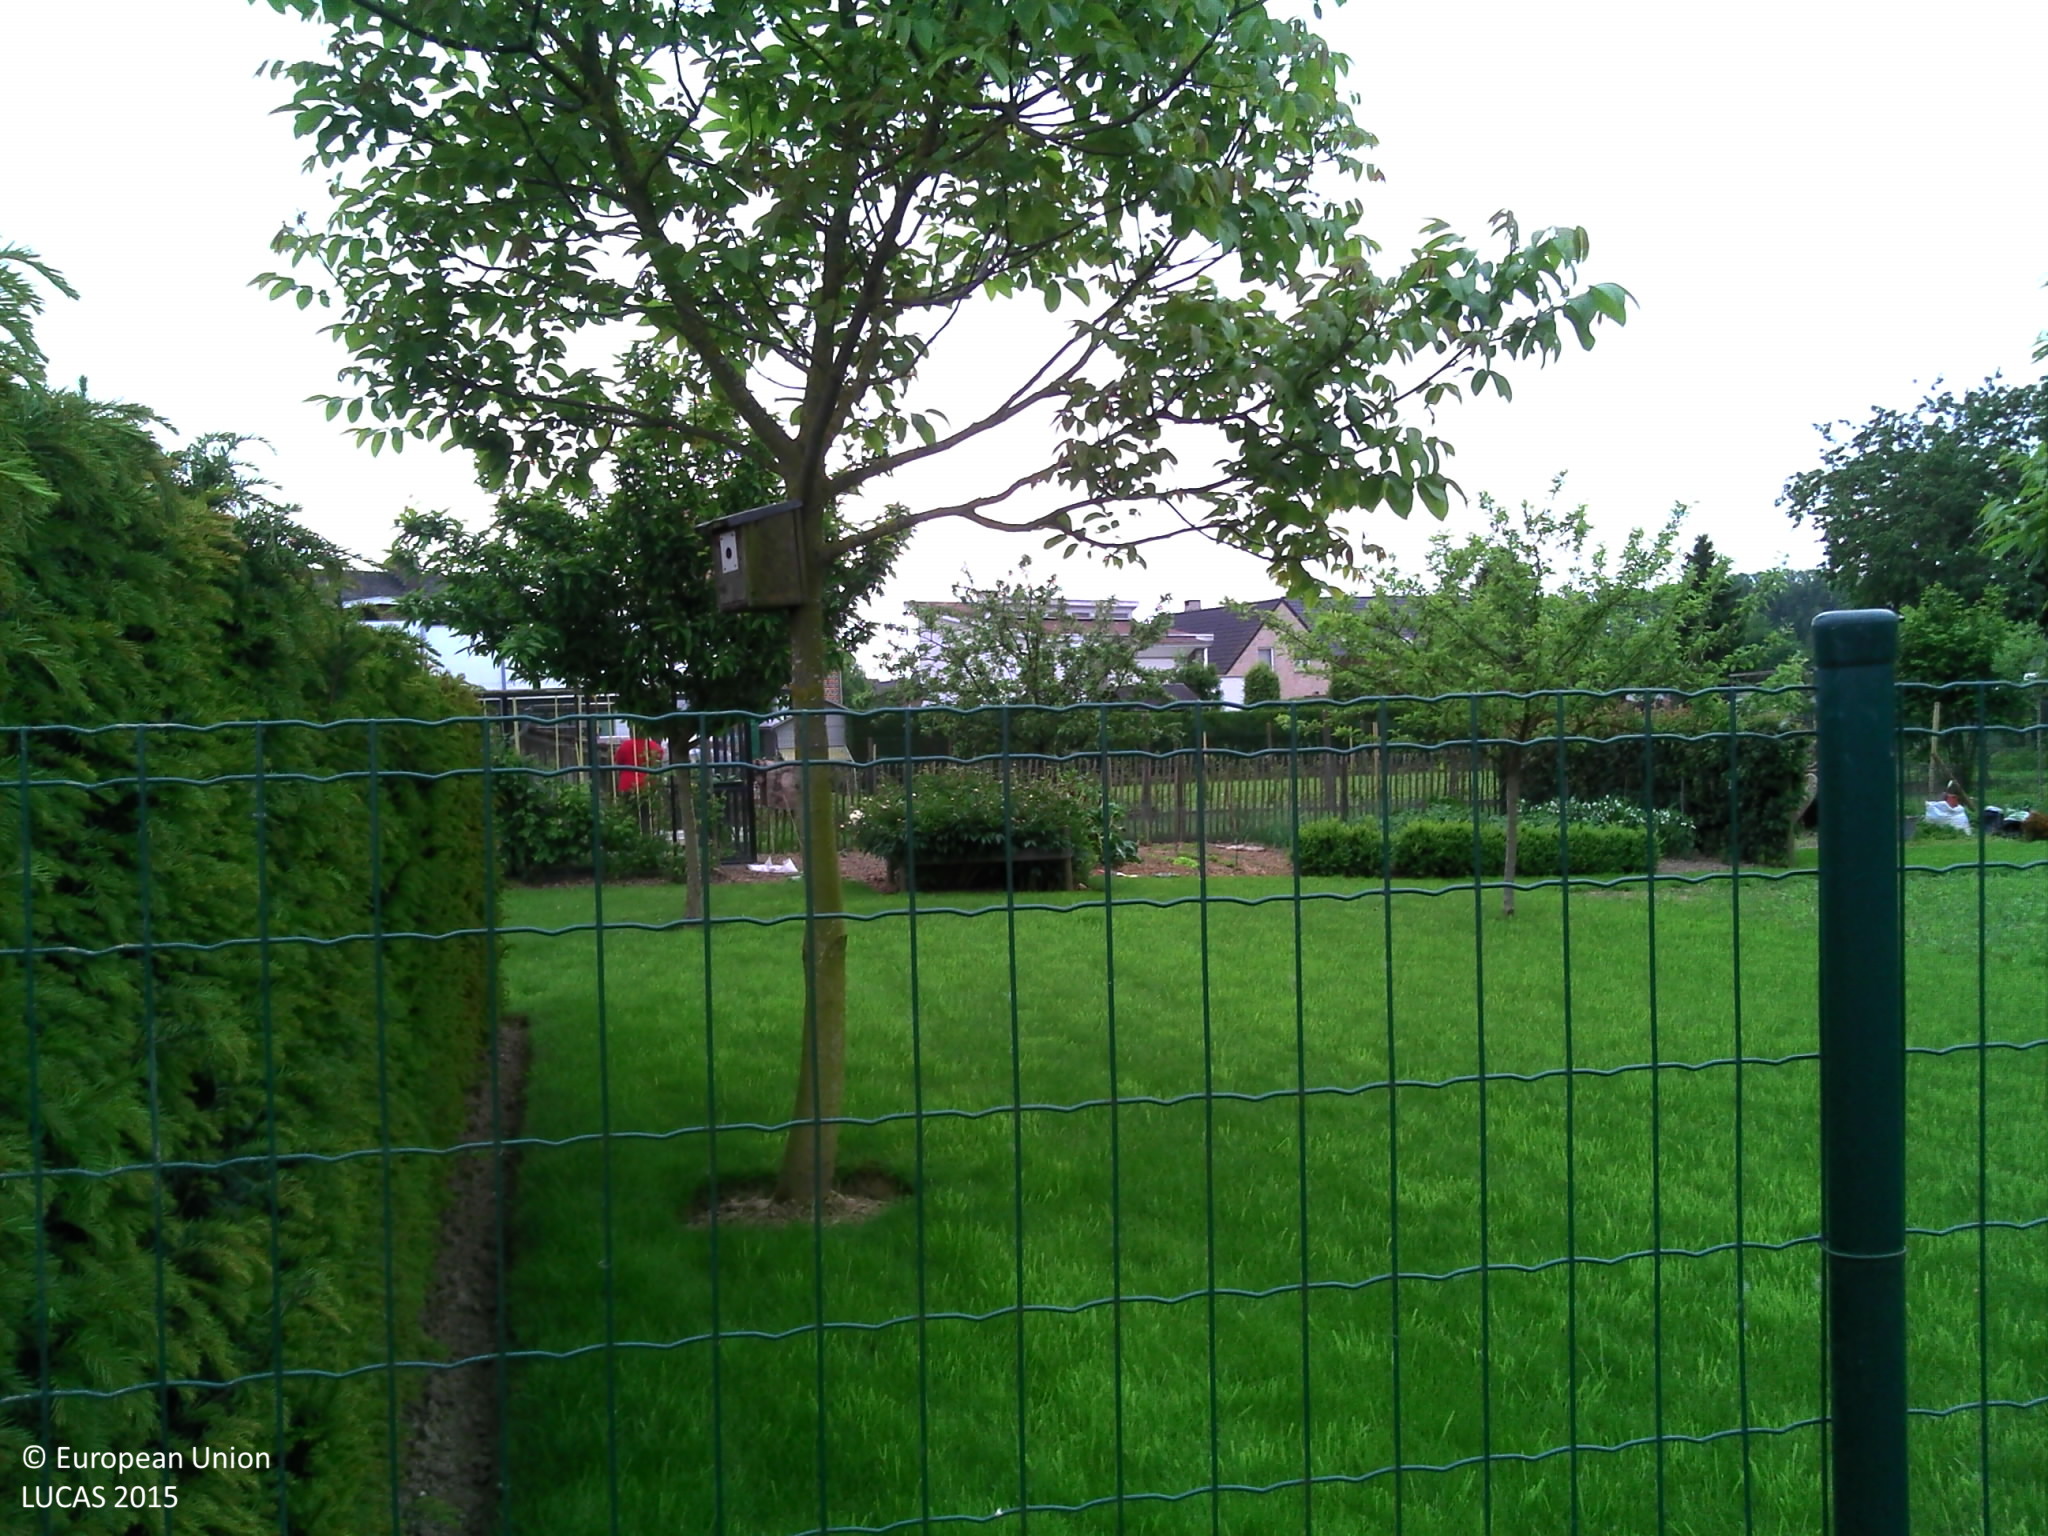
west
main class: Grassland
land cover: Grassland without tree/shrub cover
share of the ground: > 75 %
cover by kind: herbaceous plants 95 %, shrubs 5 %
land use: Residential
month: May
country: BE
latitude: 50.7460
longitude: 3.9708
